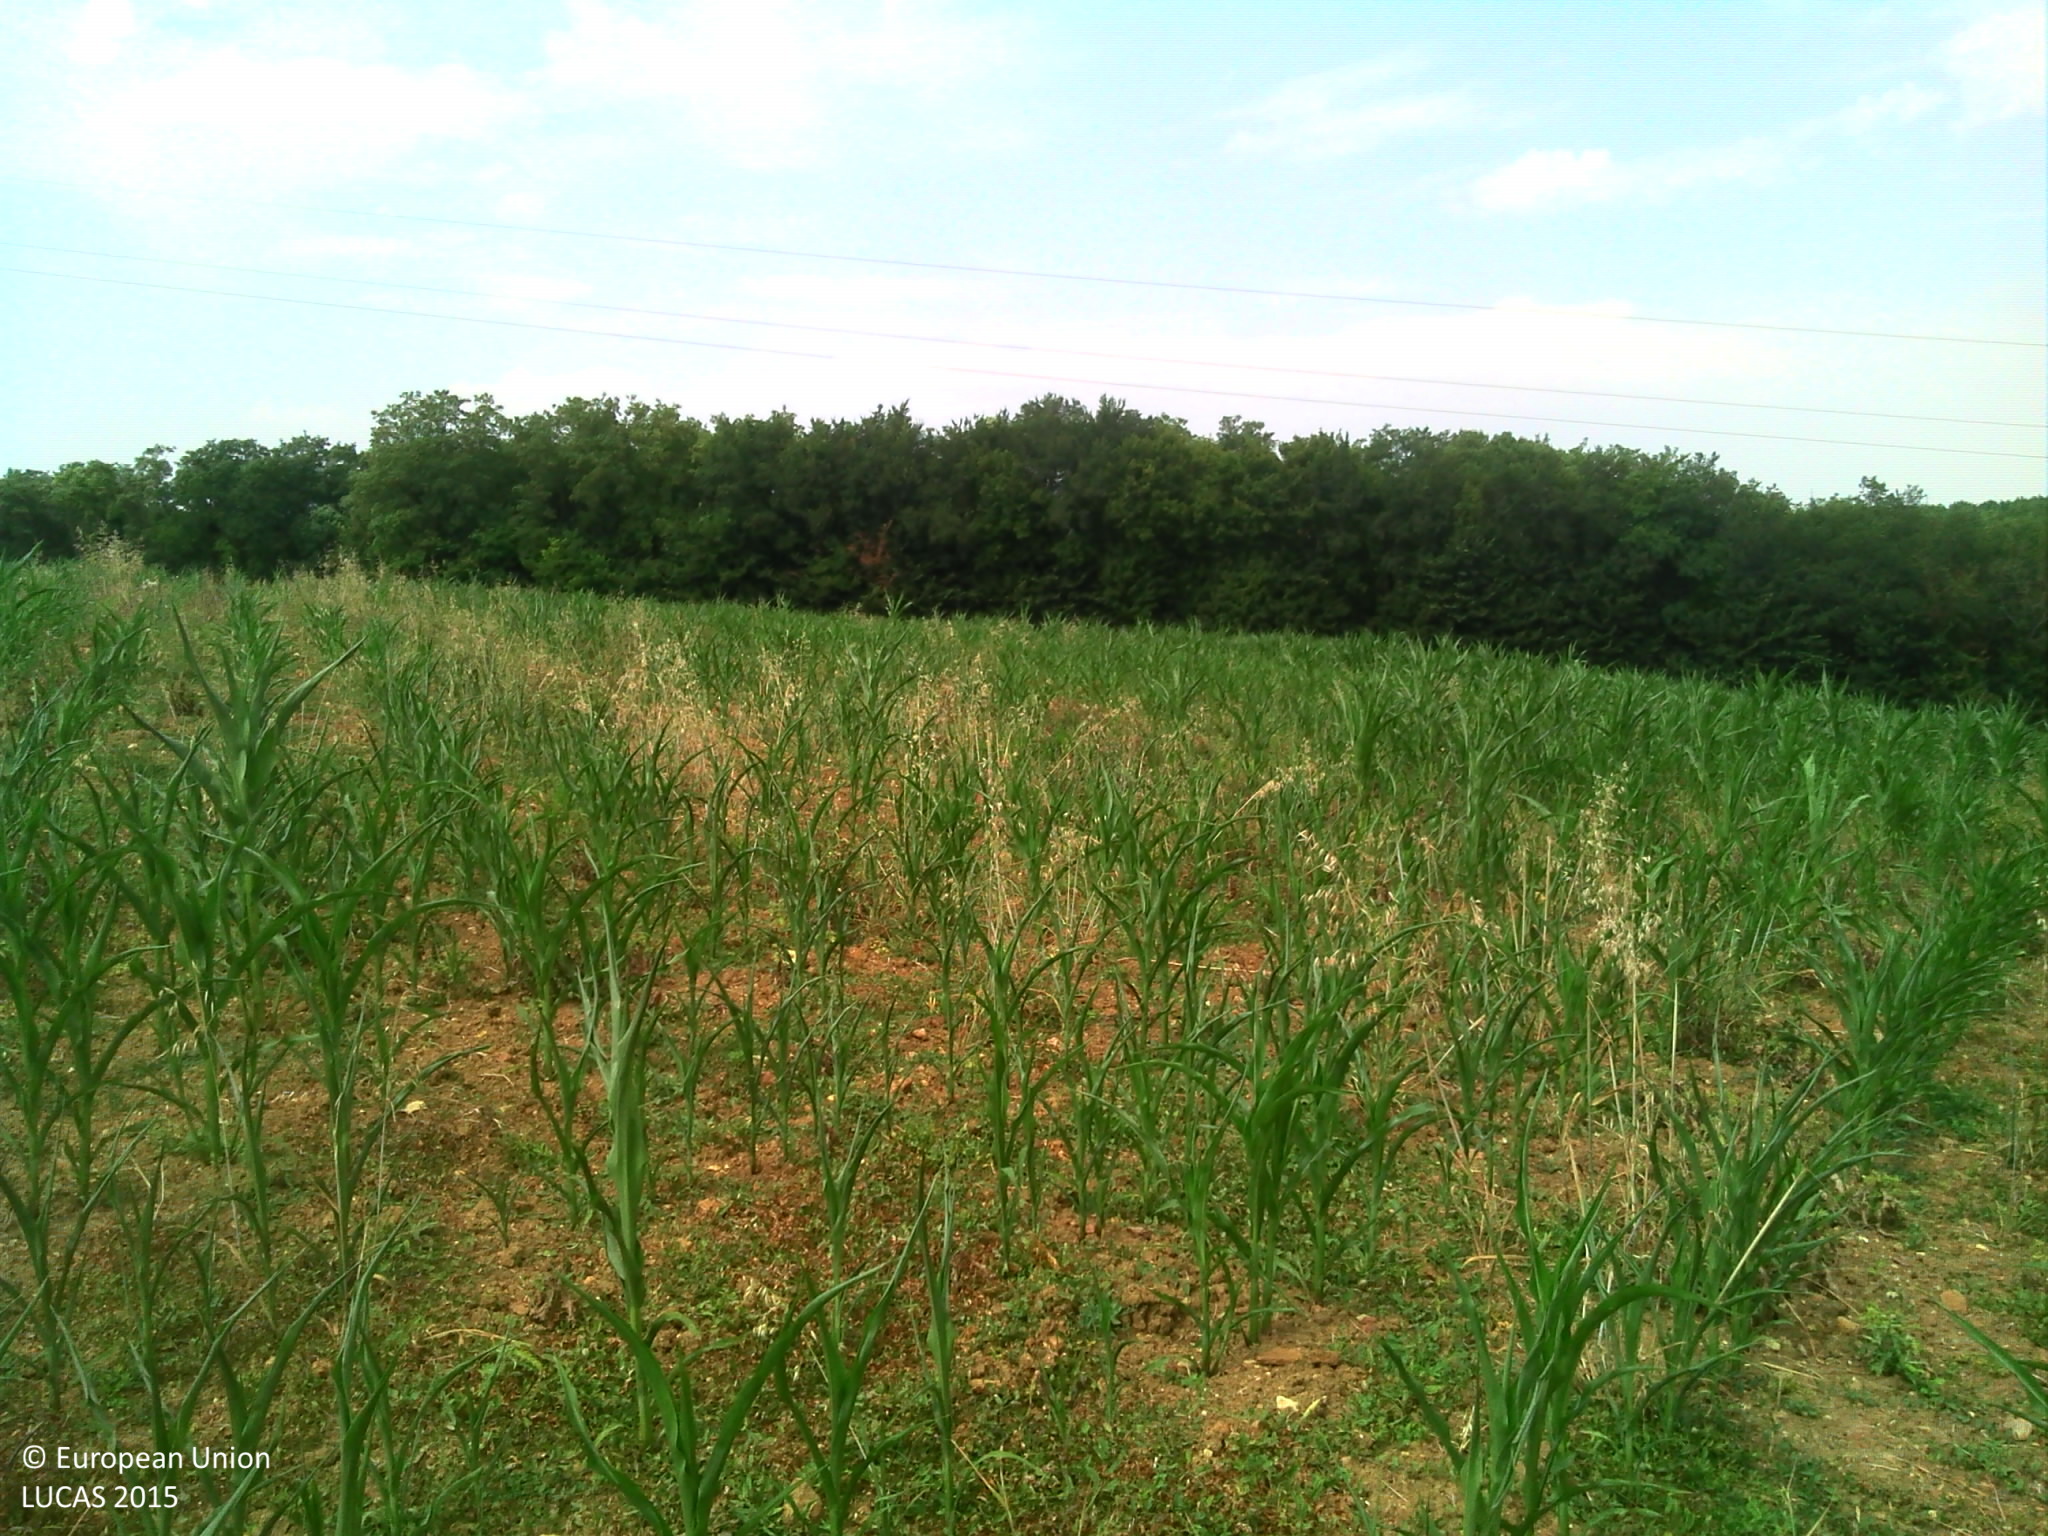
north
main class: Cropland
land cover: Maize
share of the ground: 25 - 50 %
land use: Agriculture (excluding fallow land and kitchen gardens)
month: July
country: FR
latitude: 47.2621
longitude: 0.4238
